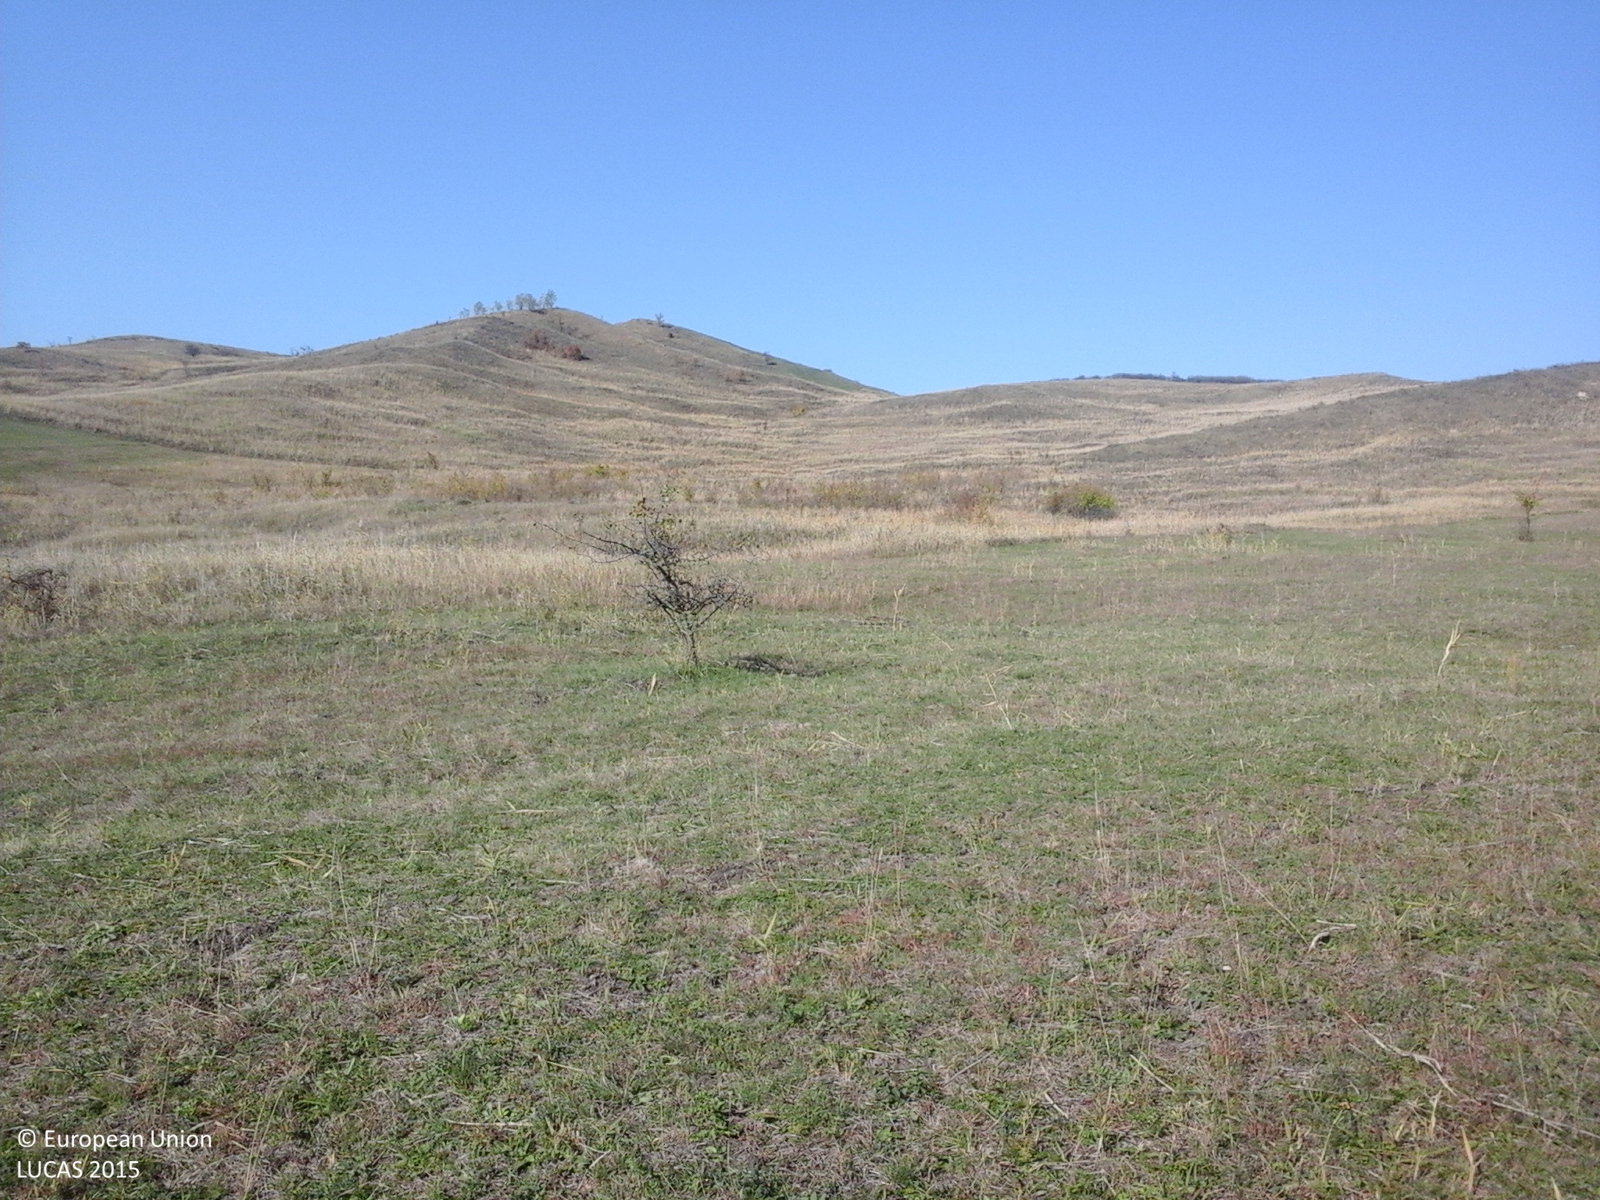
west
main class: Grassland
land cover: Grassland with sparse tree/shrub cover
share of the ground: > 75 %
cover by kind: herbaceous plants 85 %, shrubs 10 %, broadleaved forest trees 5 %
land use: Agriculture (excluding fallow land and kitchen gardens)
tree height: < 5 m
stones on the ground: < 10 %
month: October
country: RO
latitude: 45.3133
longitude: 26.5150
